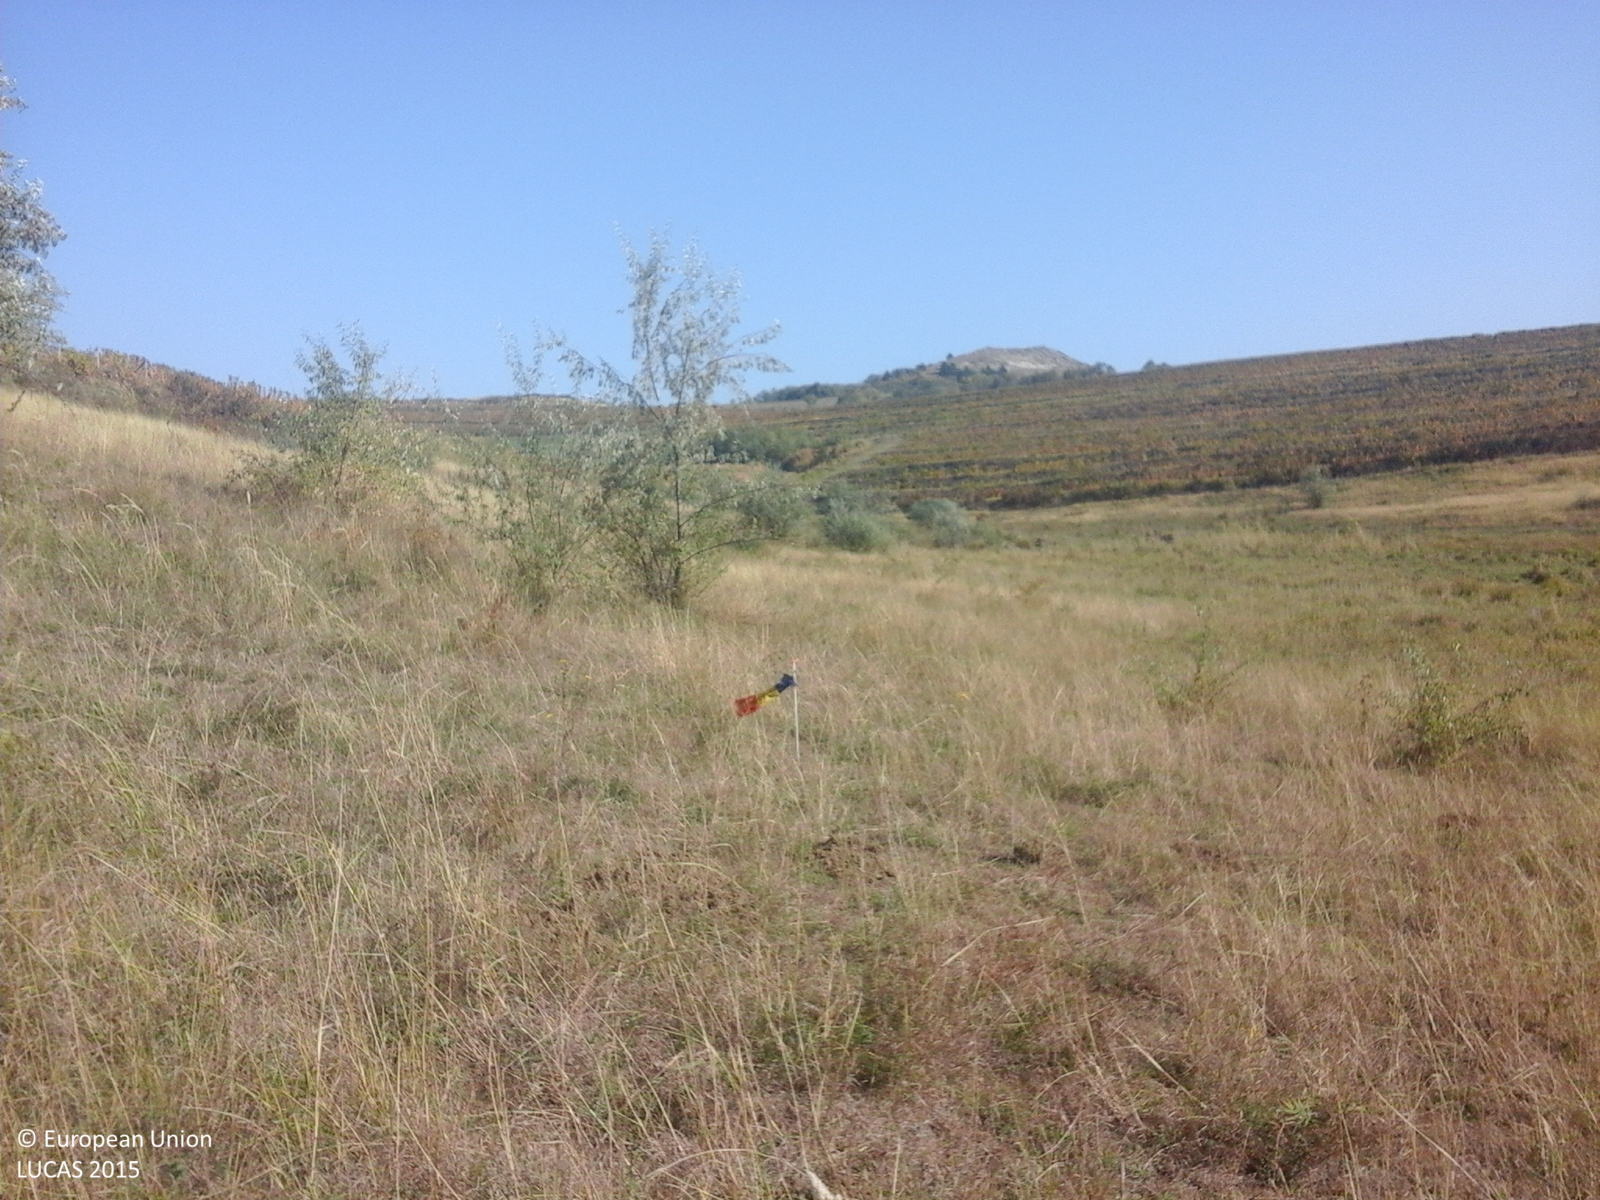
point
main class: Grassland
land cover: Grassland with sparse tree/shrub cover
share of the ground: > 75 %
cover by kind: herbaceous plants 85 %, shrubs 10 %, broadleaved forest trees 5 %
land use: Fallow land
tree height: < 5 m
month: October
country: RO
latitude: 45.0719
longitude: 26.4156
